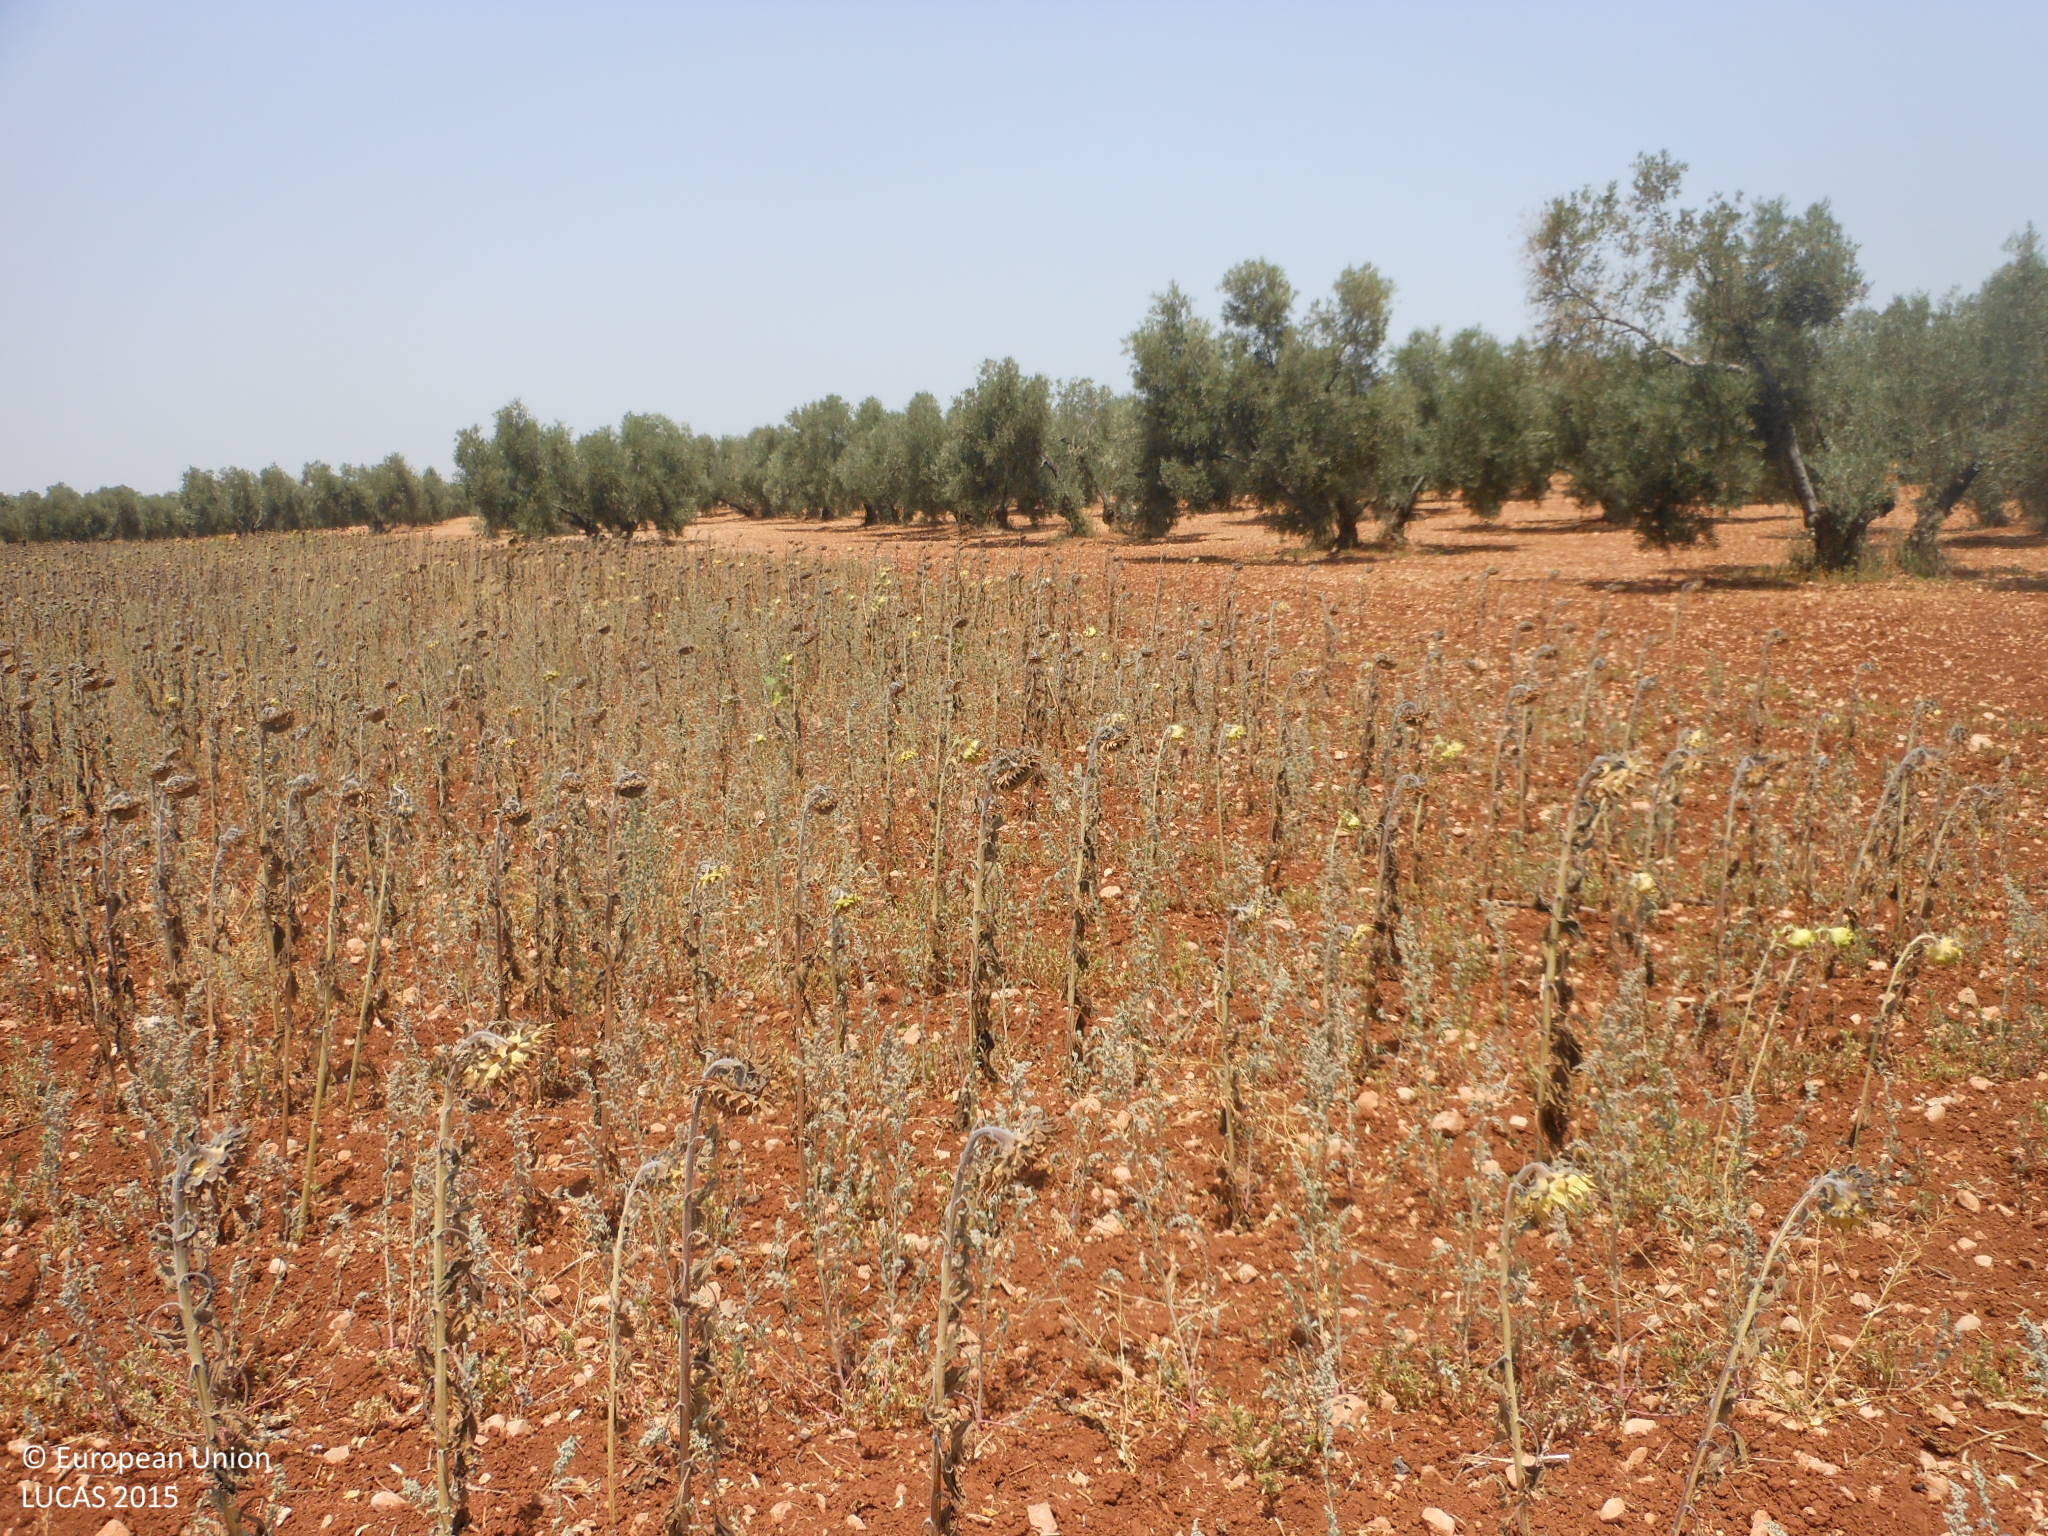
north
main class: Cropland
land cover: Sunflower
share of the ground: 25 - 50 %
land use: Agriculture (excluding fallow land and kitchen gardens)
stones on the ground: 10 - 25 %
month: July
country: ES
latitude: 37.3617
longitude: -5.1055
